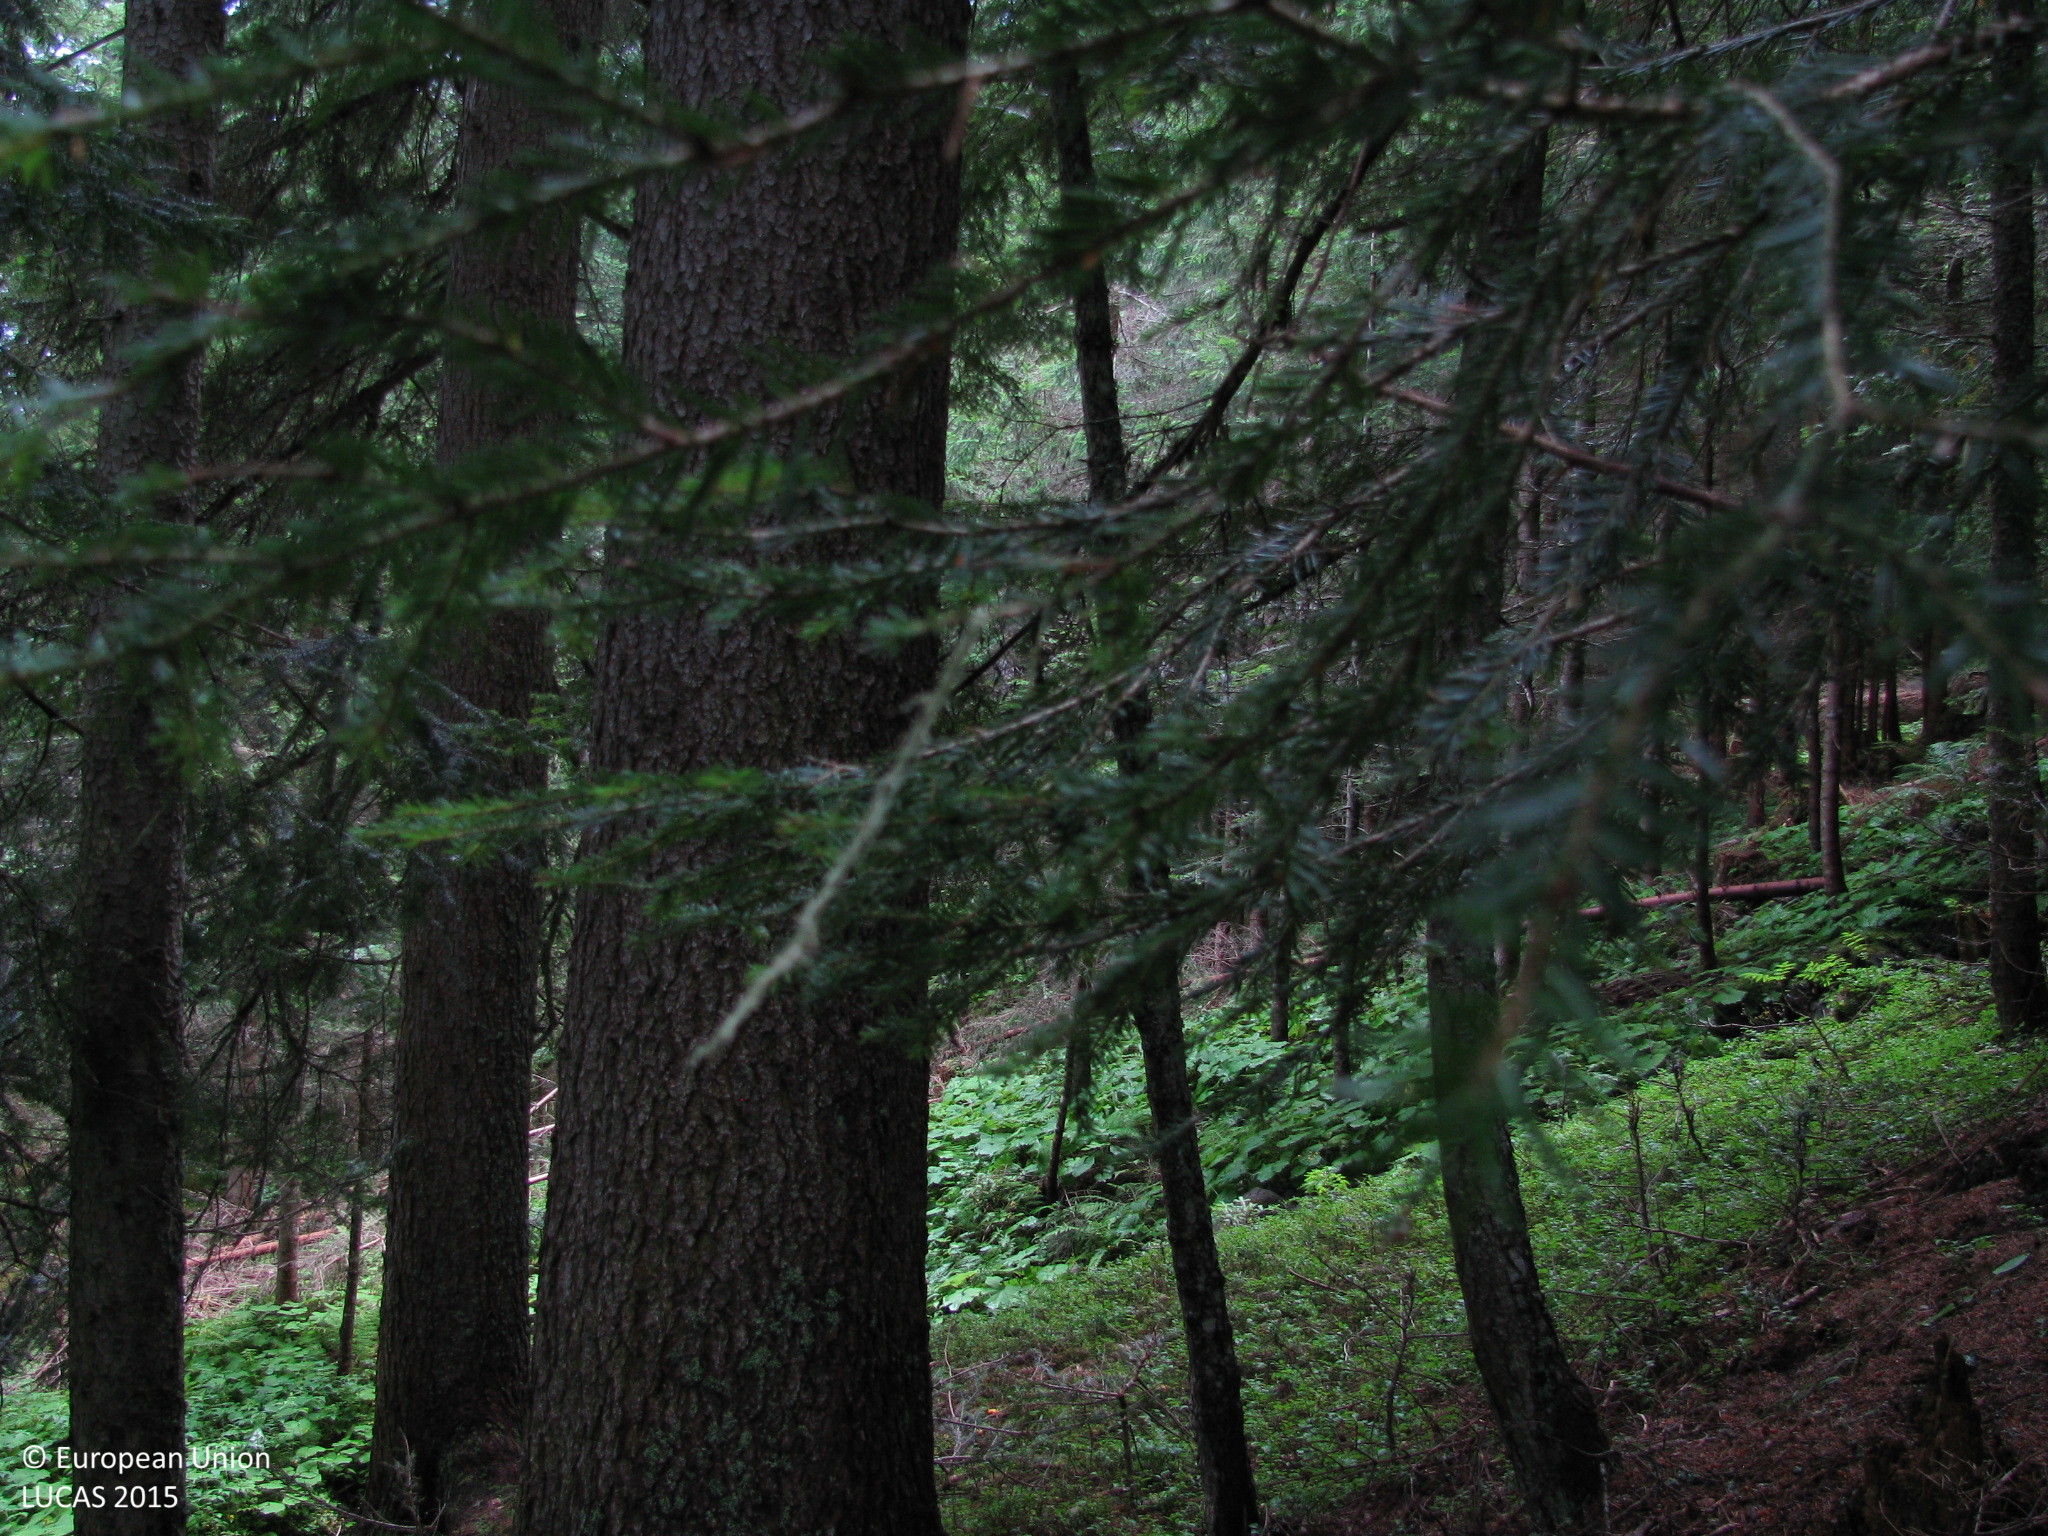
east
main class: Woodland
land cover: Spruce dominated coniferous woodland
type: alpine coniferous forest
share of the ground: > 75 %
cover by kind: coniferous forest trees 75 %, shrubs 10 %, herbaceous plants 10 %, lichens and mosses 5 %
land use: Forestry
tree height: > 5 m
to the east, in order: Spruce dominated coniferous woodland; Rivers and streams; Spruce dominated coniferous woodland; Tracks; Spruce dominated coniferous woodland
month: July
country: AT
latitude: 46.7377
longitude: 12.4449
